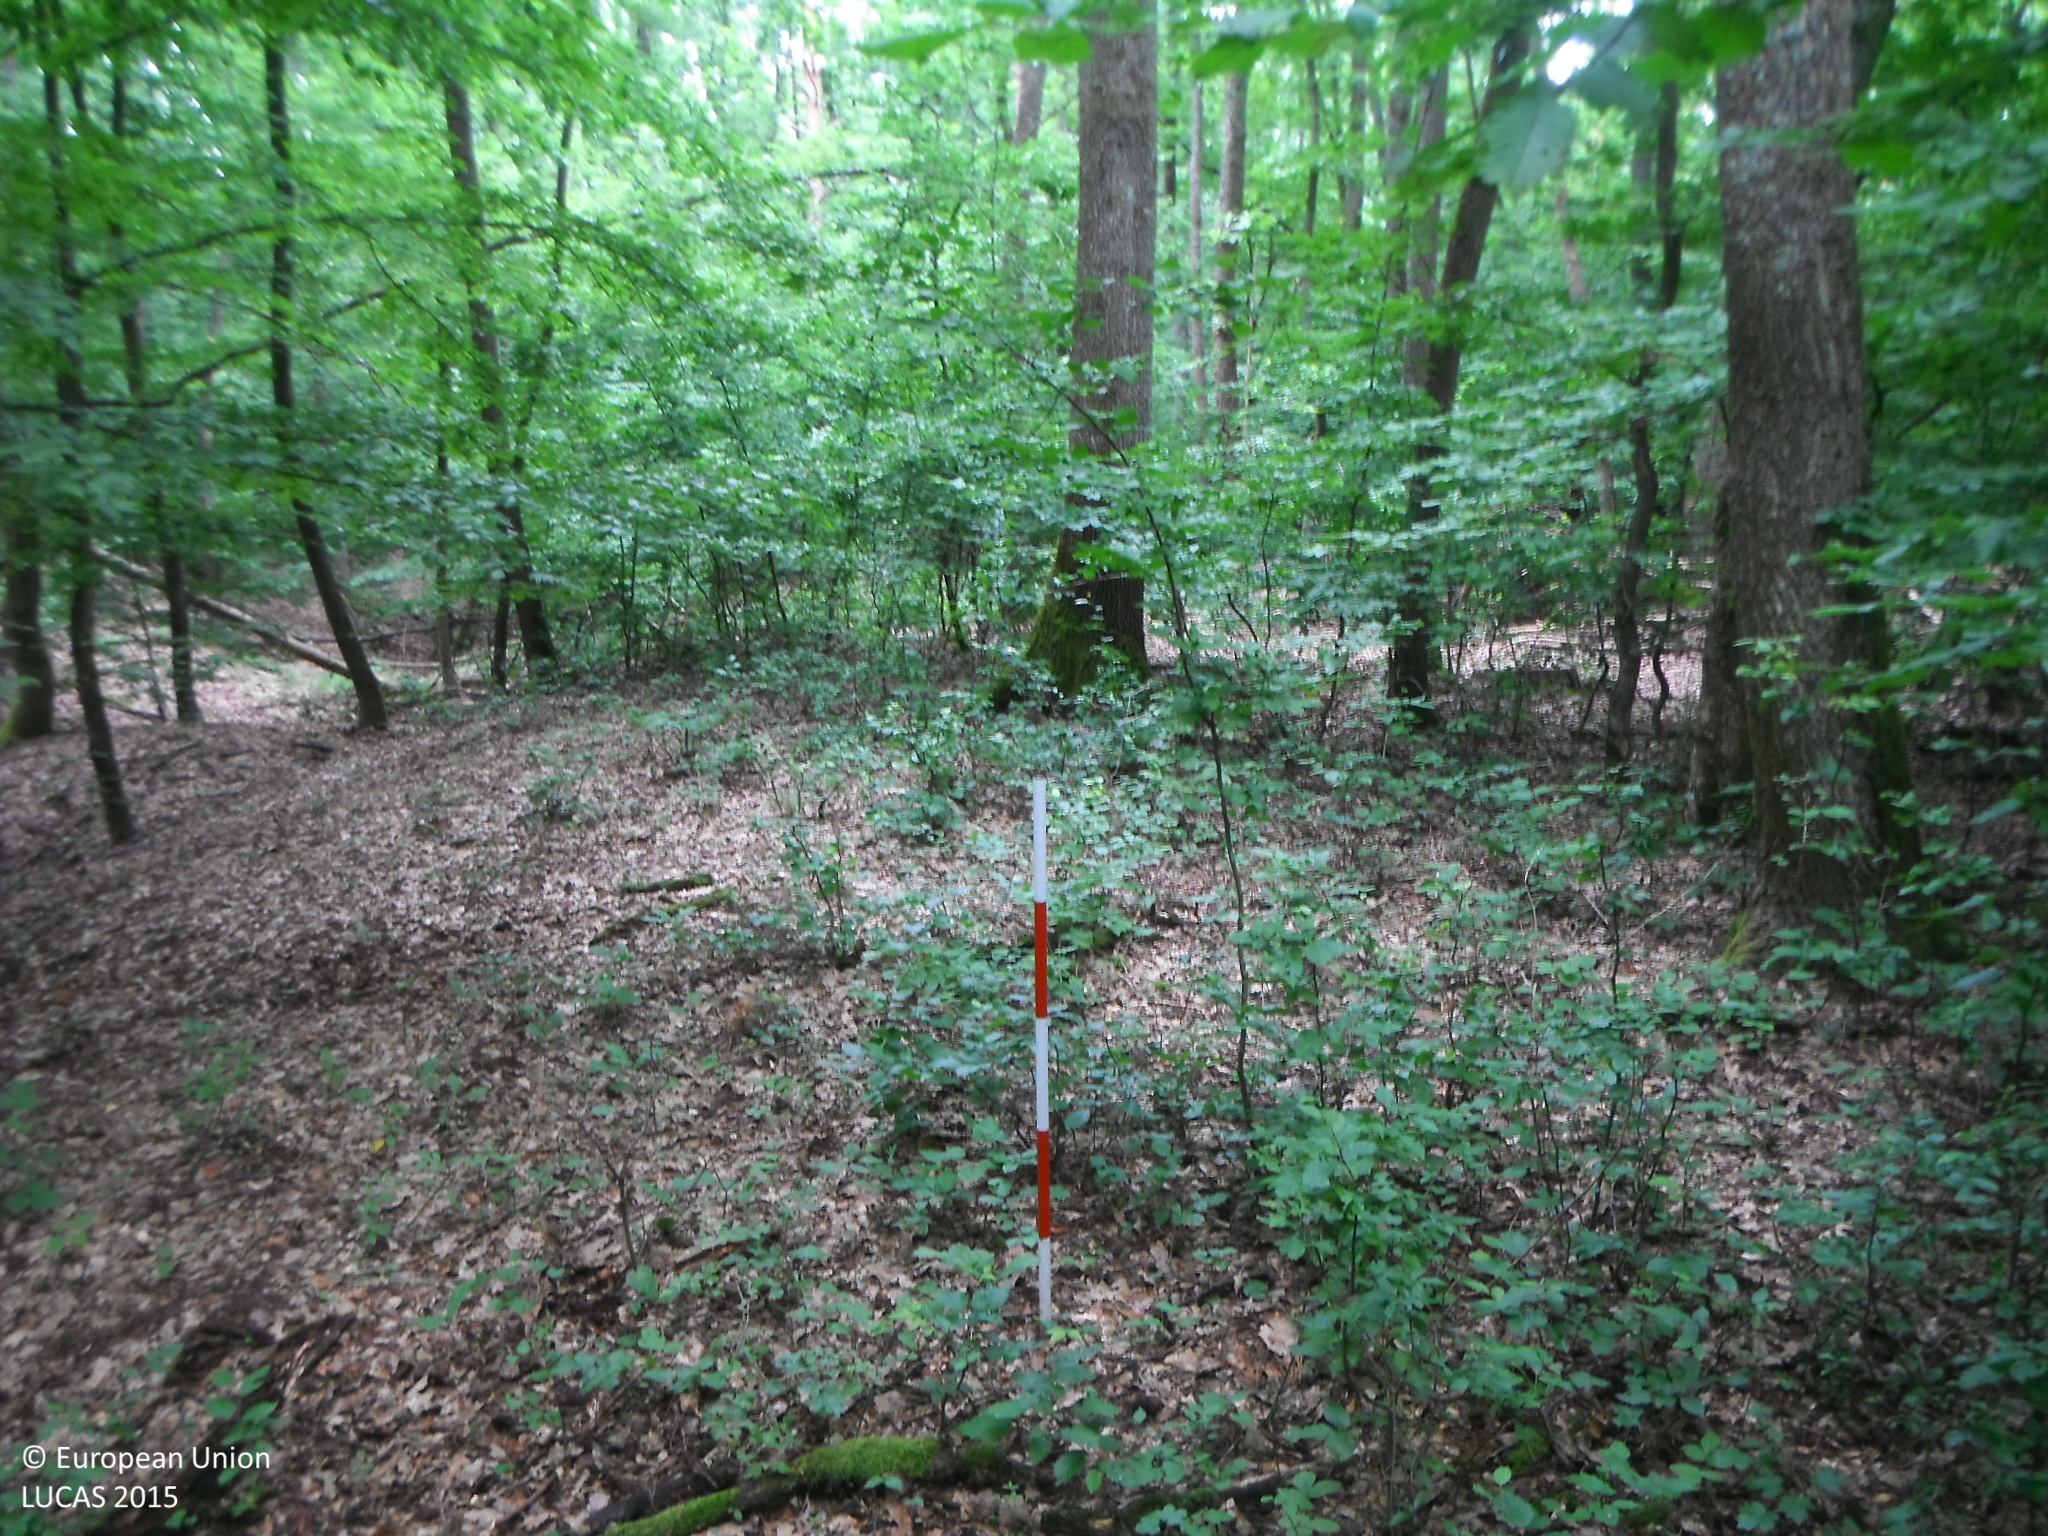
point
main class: Woodland
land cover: Broadleaved woodland
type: beech forest
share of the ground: > 75 %
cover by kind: broadleaved forest trees 100 %
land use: Forestry
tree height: > 5 m
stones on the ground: > 50 %
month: June
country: SK
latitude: 48.4730
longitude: 20.2172
